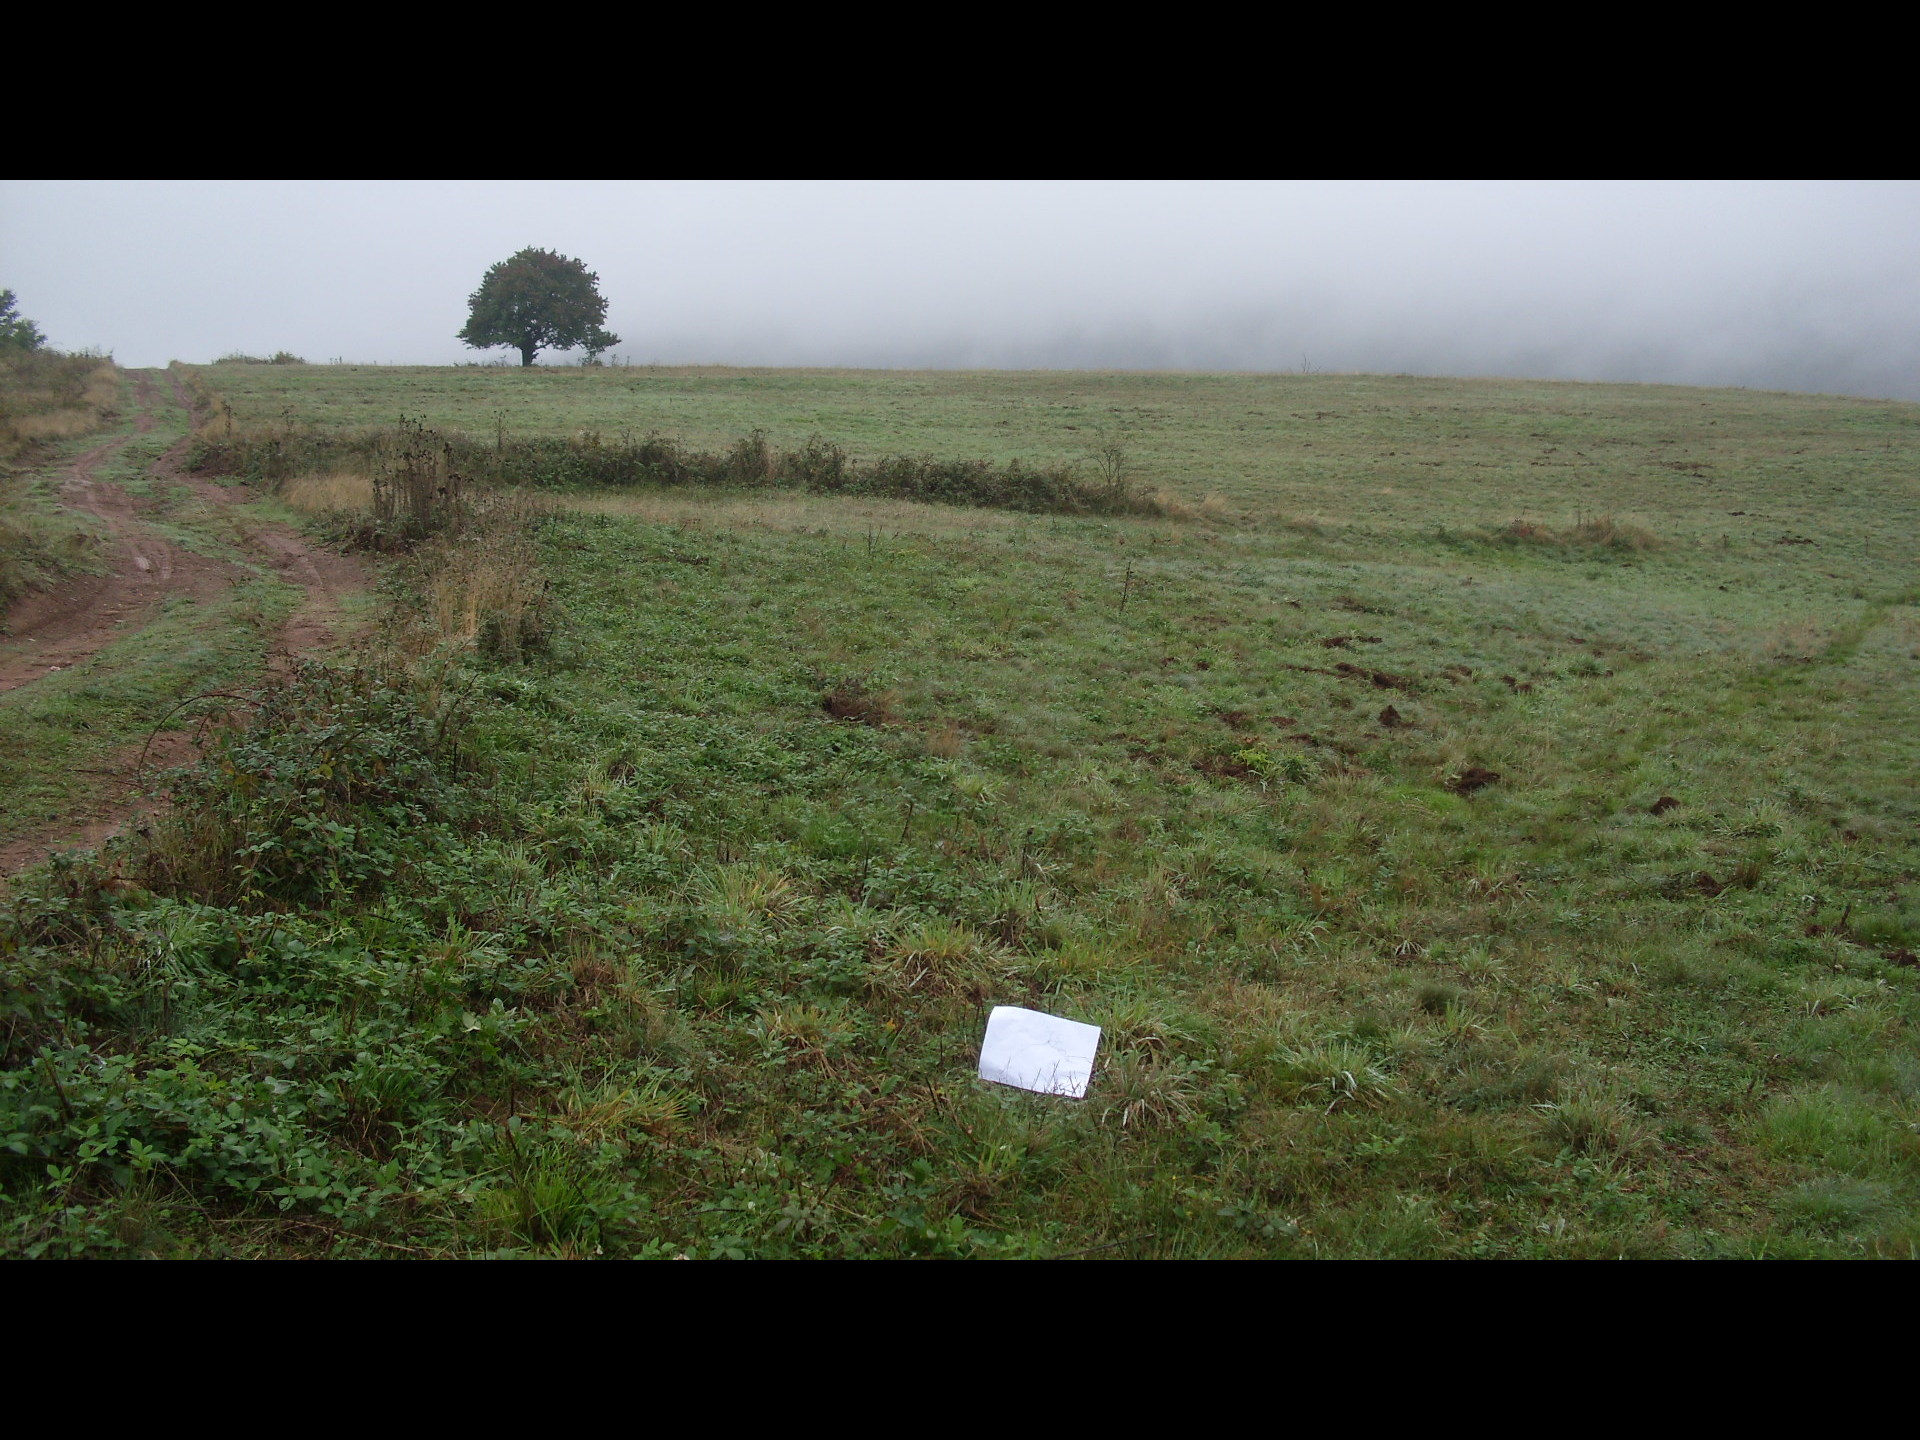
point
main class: Grassland
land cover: Grassland without tree/shrub cover
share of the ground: > 75 %
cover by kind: herbaceous plants 95 %, unconsolidated bare surface 5 %
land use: Agriculture (excluding fallow land and kitchen gardens)
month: October
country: BG
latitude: 43.5191
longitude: 22.7893
